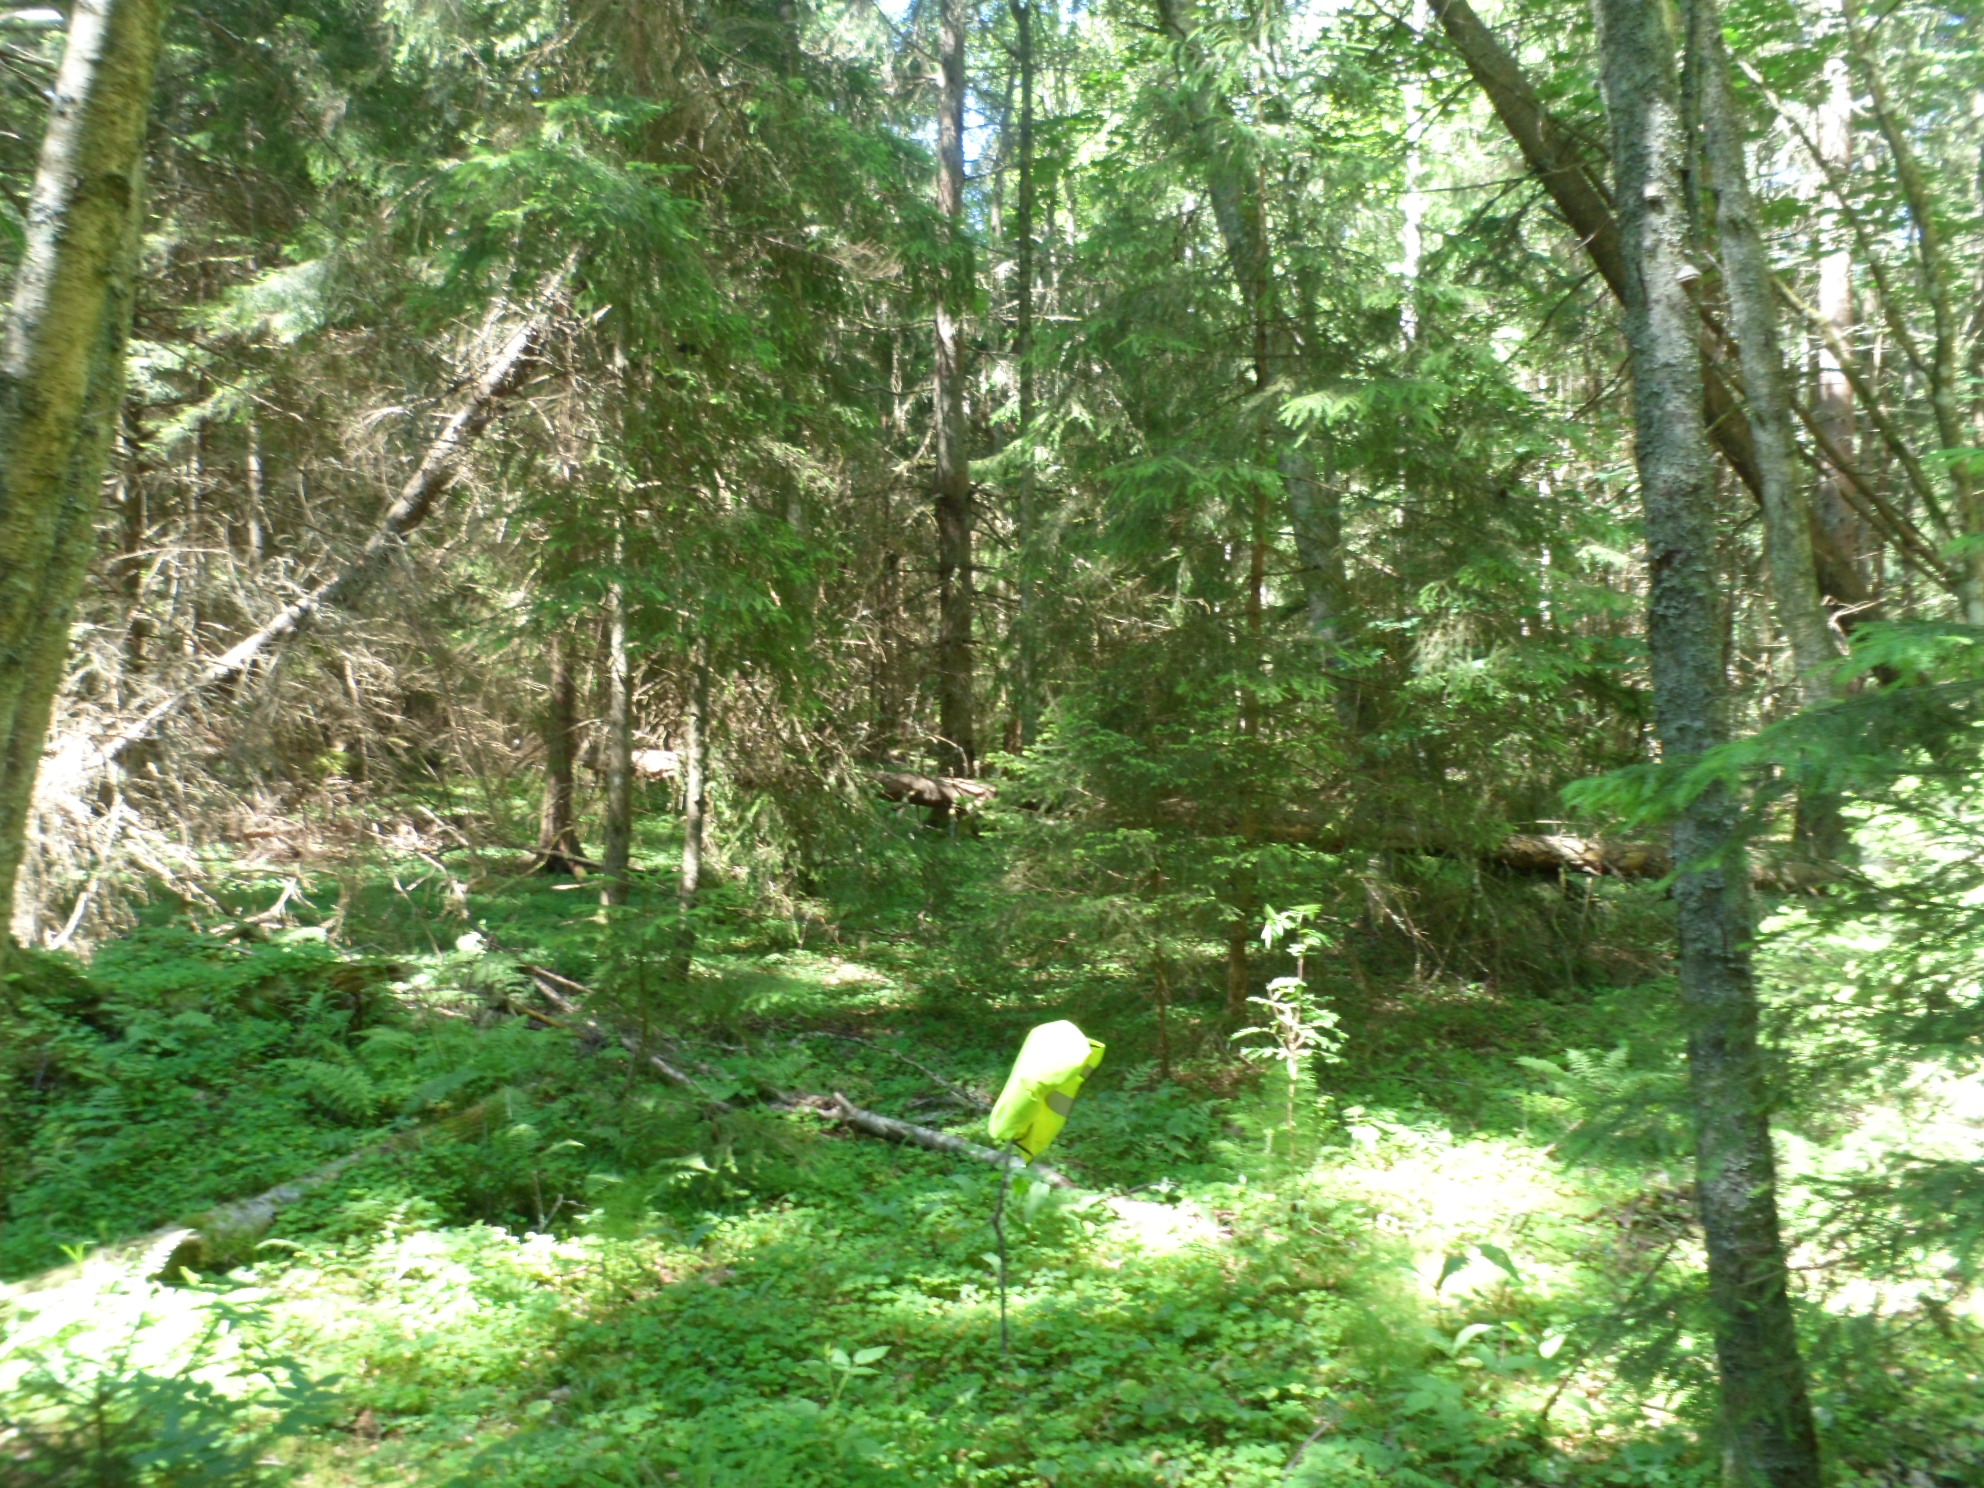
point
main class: Woodland
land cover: Spruce dominated mixed woodland
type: boreal forest
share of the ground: 50 - 75 %
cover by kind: coniferous forest trees 45 %, broadleaved forest trees 30 %, herbaceous plants 10 %, lichens and mosses 10 %, shrubs 5 %
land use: Forestry
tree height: > 5 m
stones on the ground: < 10 %
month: July
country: SE
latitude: 57.0814
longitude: 14.5006
